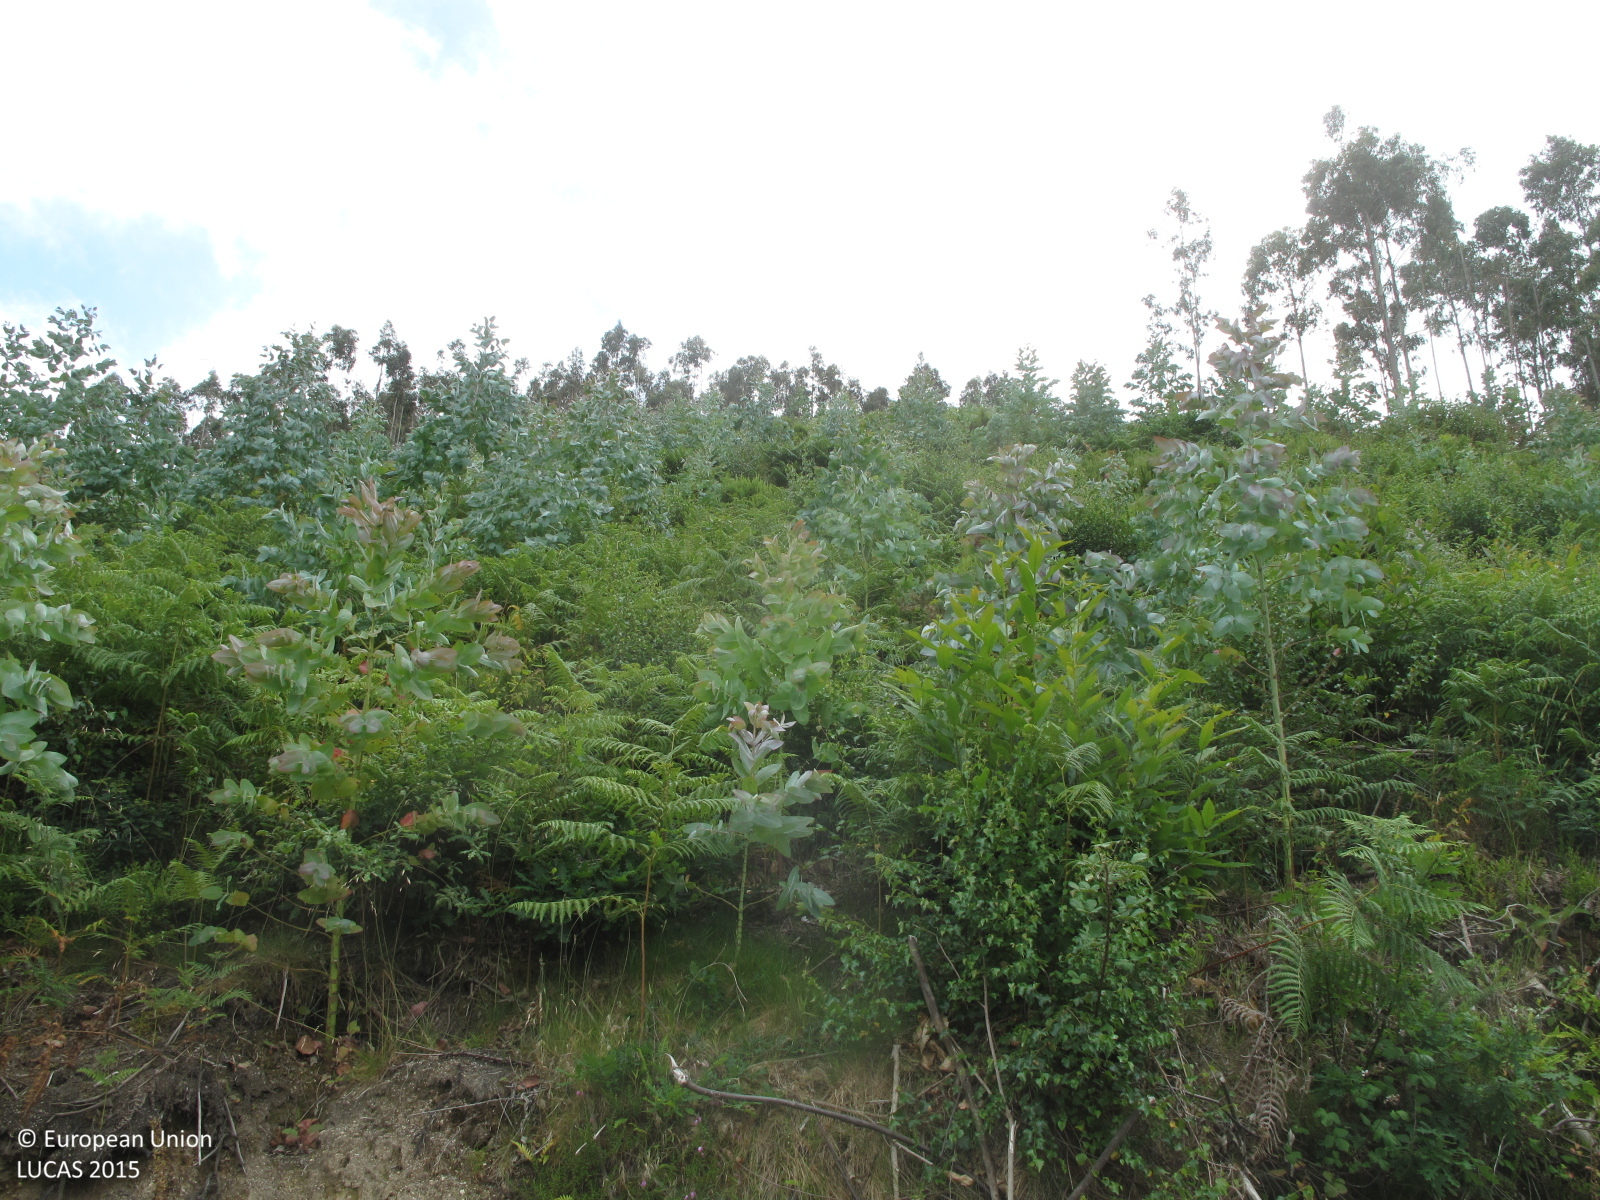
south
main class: Woodland
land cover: Broadleaved woodland
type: exotic forest
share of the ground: 10 - 25 %
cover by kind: herbaceous plants 70 %, broadleaved forest trees 20 %, shrubs 10 %
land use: Forestry
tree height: < 5 m
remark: Clear cut
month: July
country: ES
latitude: 43.4824
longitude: -7.9860
